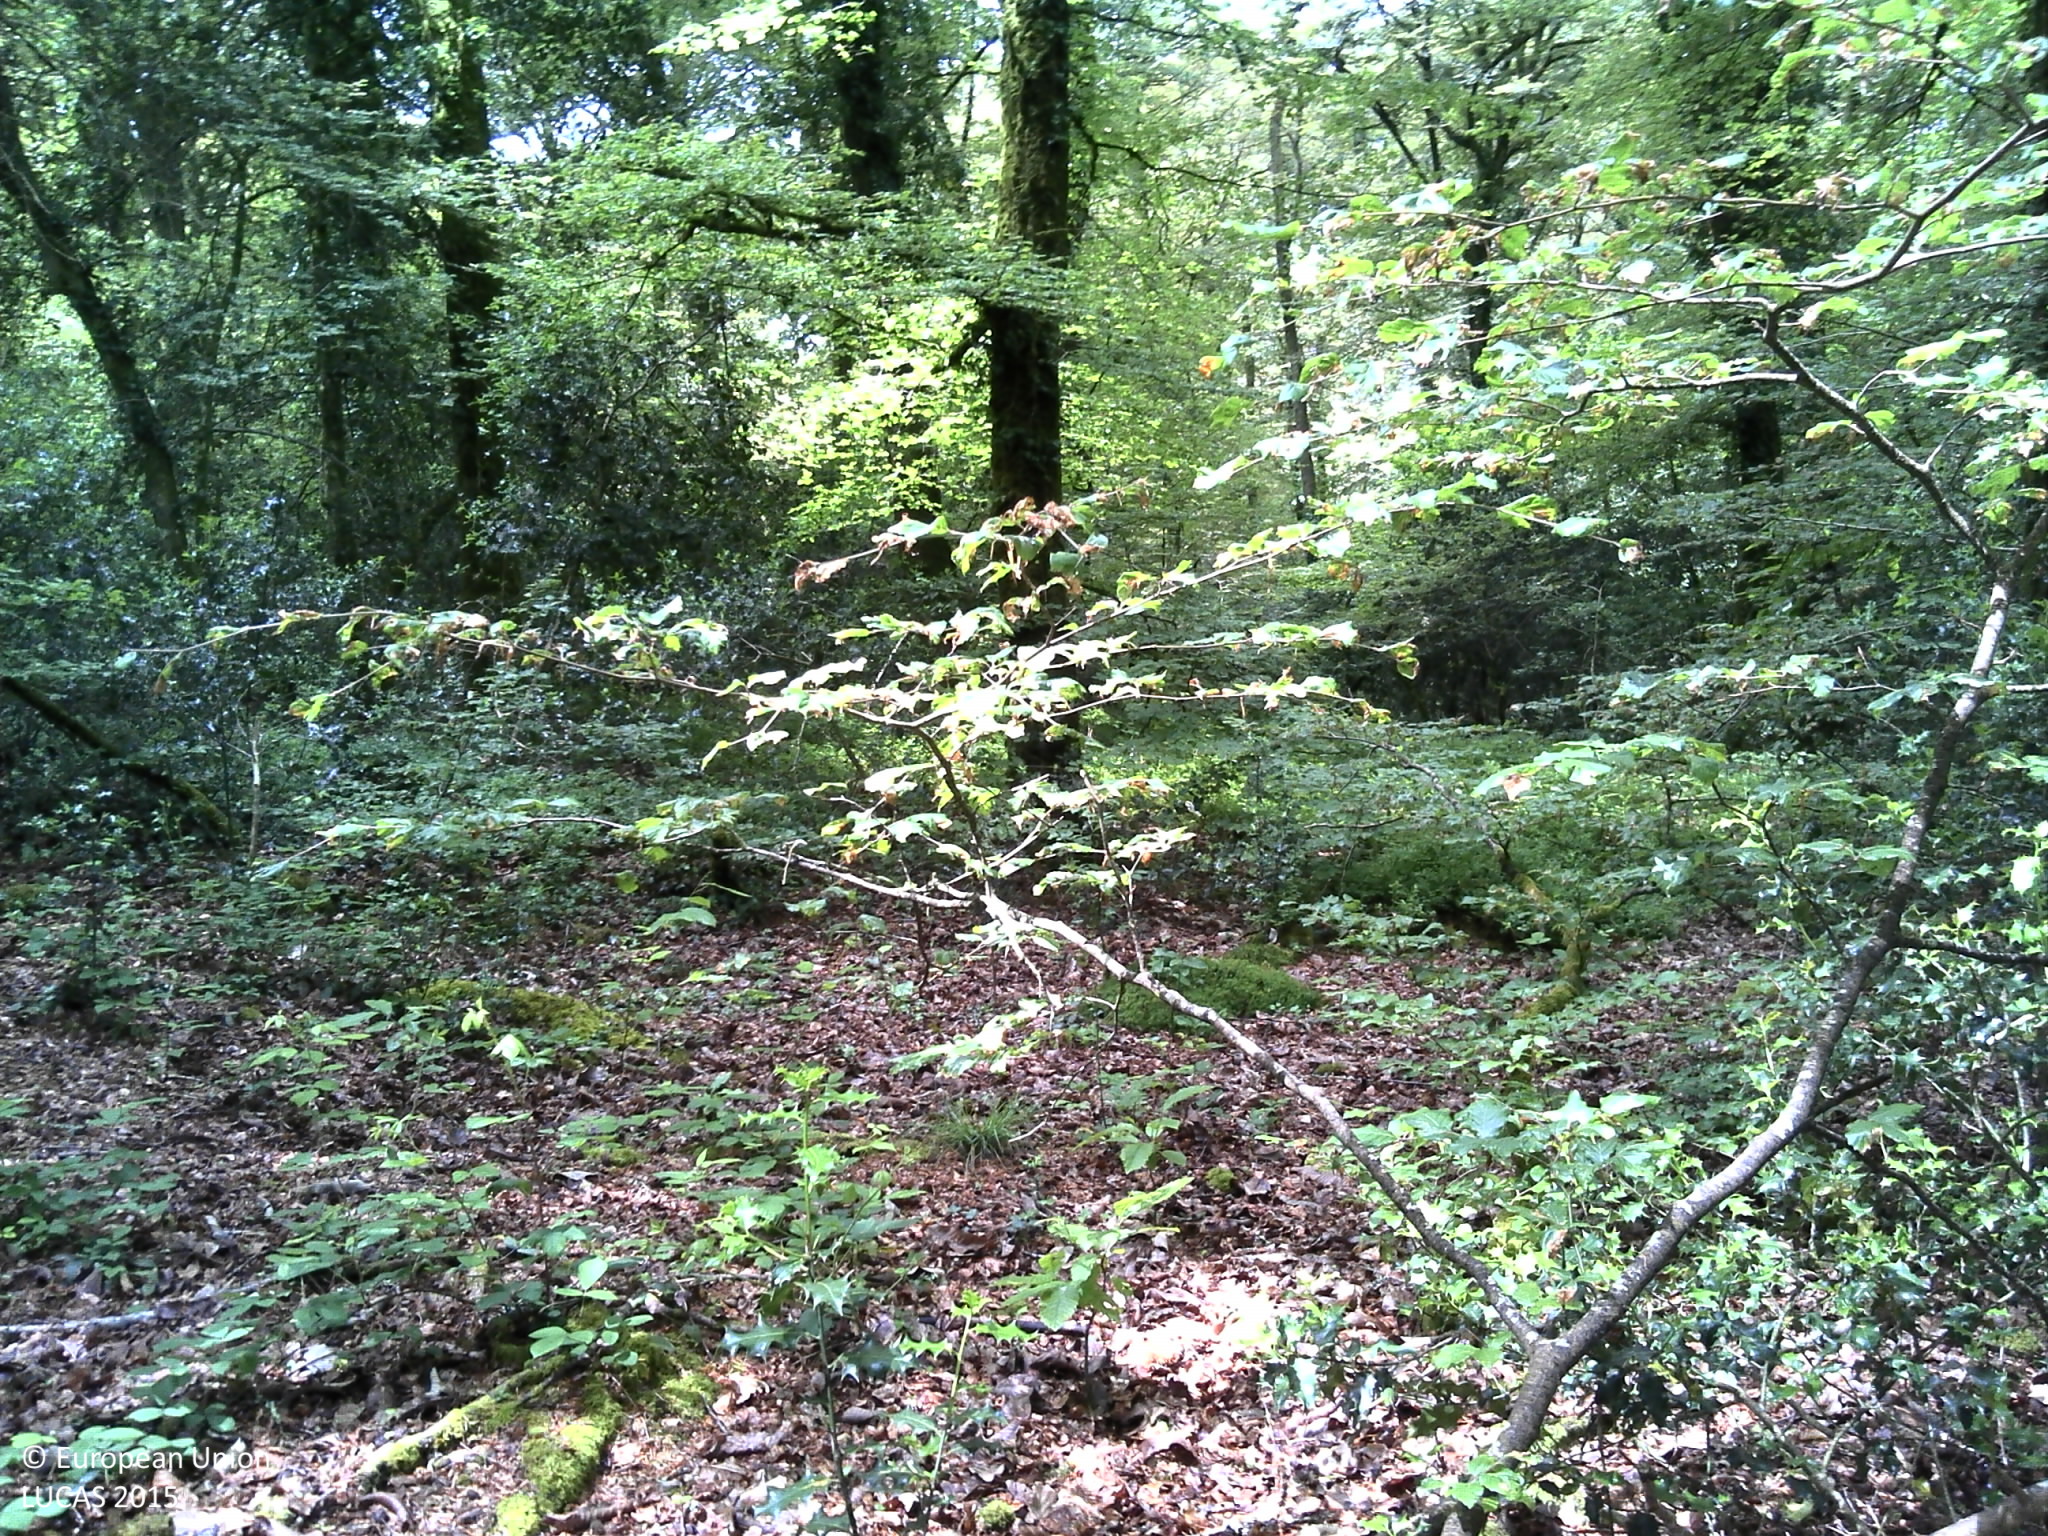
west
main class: Woodland
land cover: Broadleaved woodland
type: beech forest
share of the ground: > 75 %
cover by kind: broadleaved forest trees 95 %, herbaceous plants 5 %
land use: Forestry
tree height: > 5 m
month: June
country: FR
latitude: 47.8373
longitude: -3.5578
